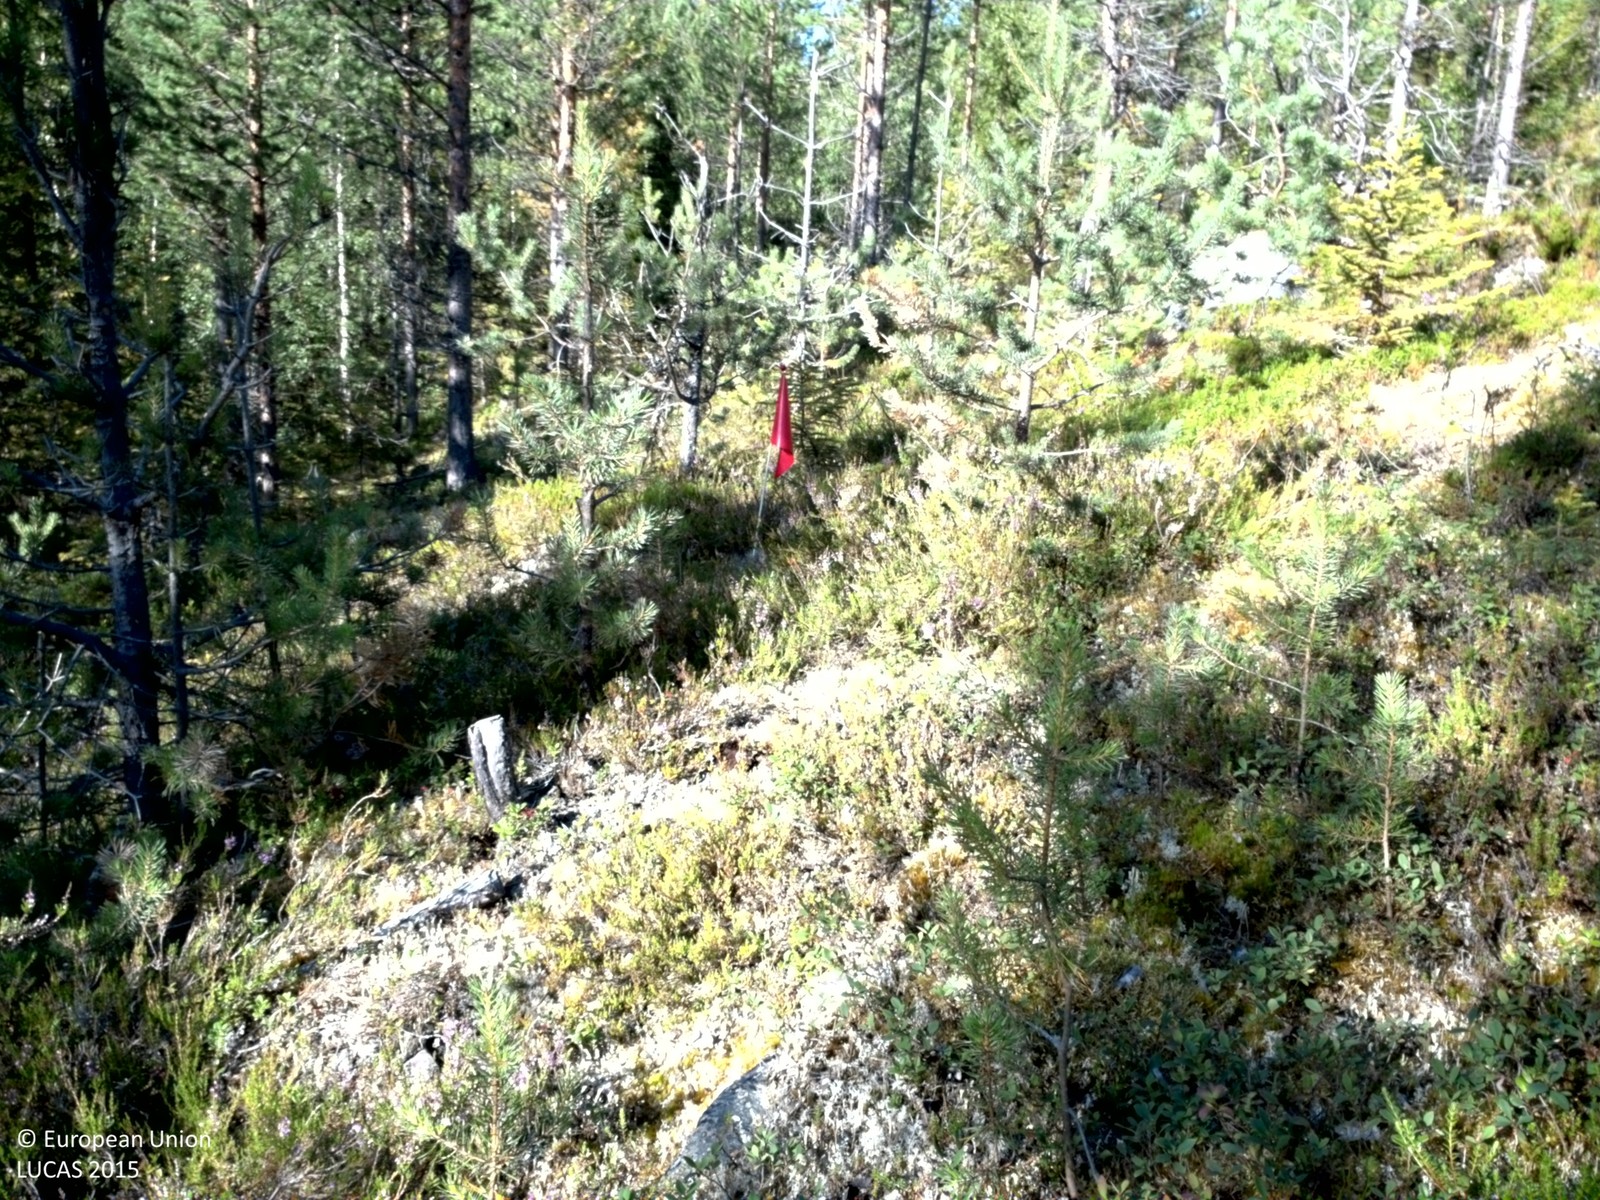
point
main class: Woodland
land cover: Pine dominated coniferous woodland
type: boreal forest
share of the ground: 25 - 50 %
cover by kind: shrubs 60 %, coniferous forest trees 25 %, broadleaved forest trees 5 %, lichens and mosses 5 %, consolidated bare surface 5 %
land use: Forestry
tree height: > 5 m
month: August
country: SE
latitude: 66.4097
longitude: 20.7295
